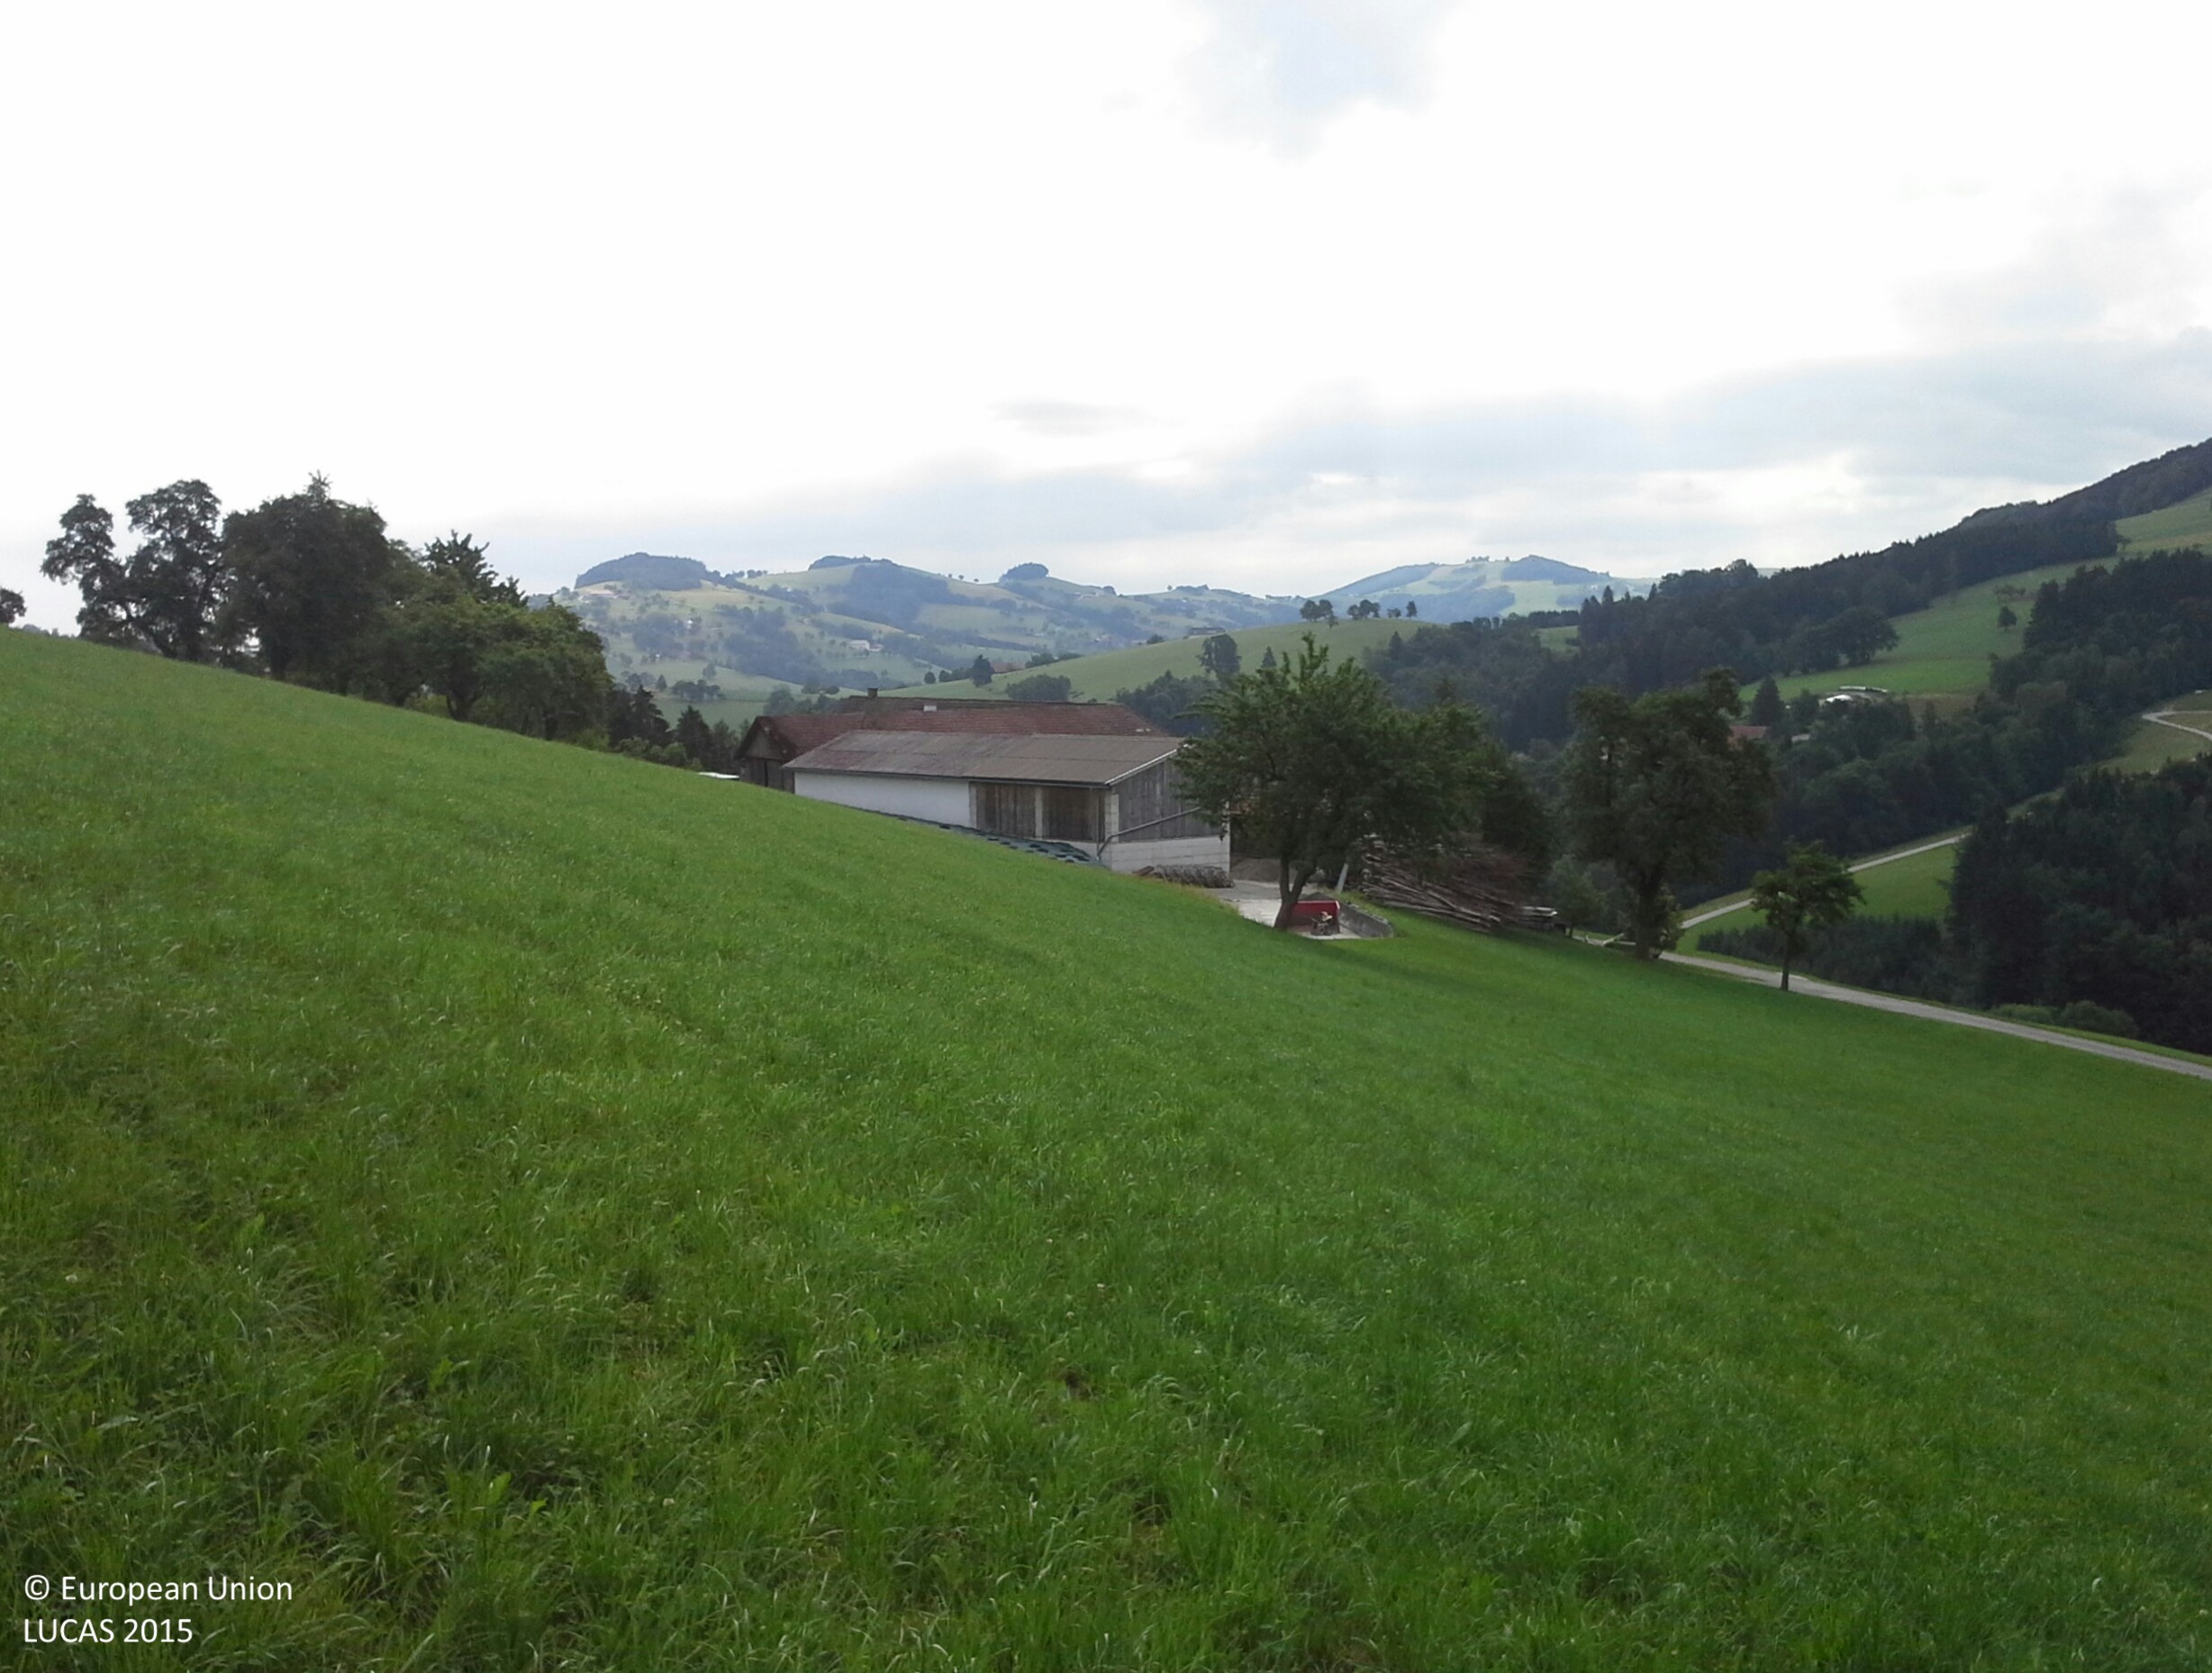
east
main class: Grassland
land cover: Grassland without tree/shrub cover
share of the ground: > 75 %
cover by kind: herbaceous plants 100 %
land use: Agriculture (excluding fallow land and kitchen gardens)
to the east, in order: Grassland without tree/shrub cover; Artificial constructions in urban areas; Pear fruit; Grassland without tree/shrub cover; Fences; Pear fruit; Grassland without tree/shrub cover
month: July
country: AT
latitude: 48.0026
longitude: 14.5706
